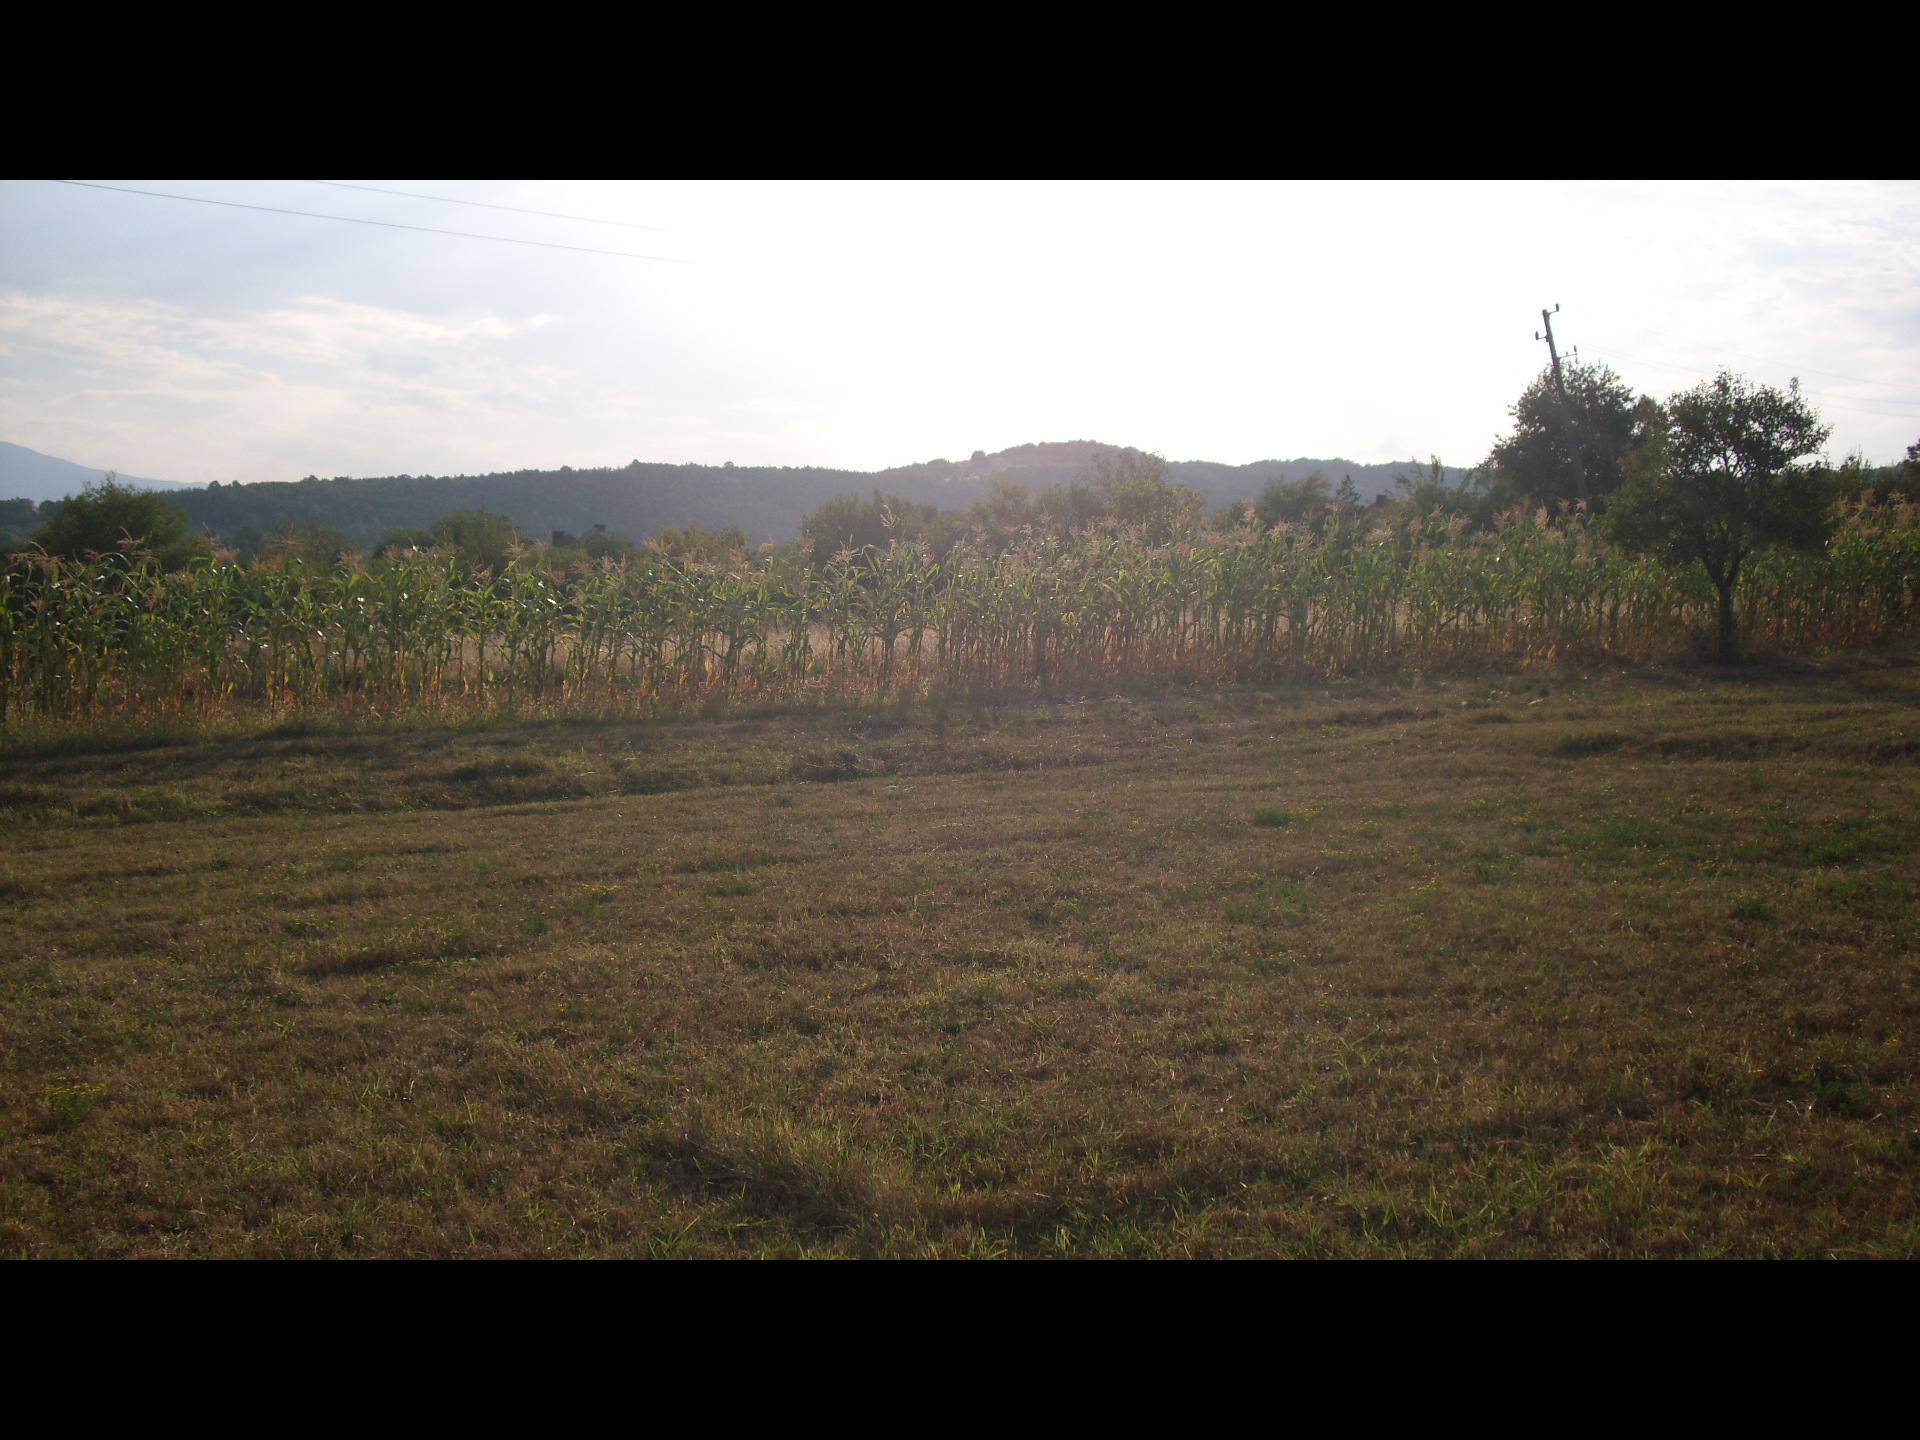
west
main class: Grassland
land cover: Grassland without tree/shrub cover
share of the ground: > 75 %
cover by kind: herbaceous plants 100 %
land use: Agriculture (excluding fallow land and kitchen gardens)
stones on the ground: < 10 %
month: August
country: BG
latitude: 43.2406
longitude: 23.2524
